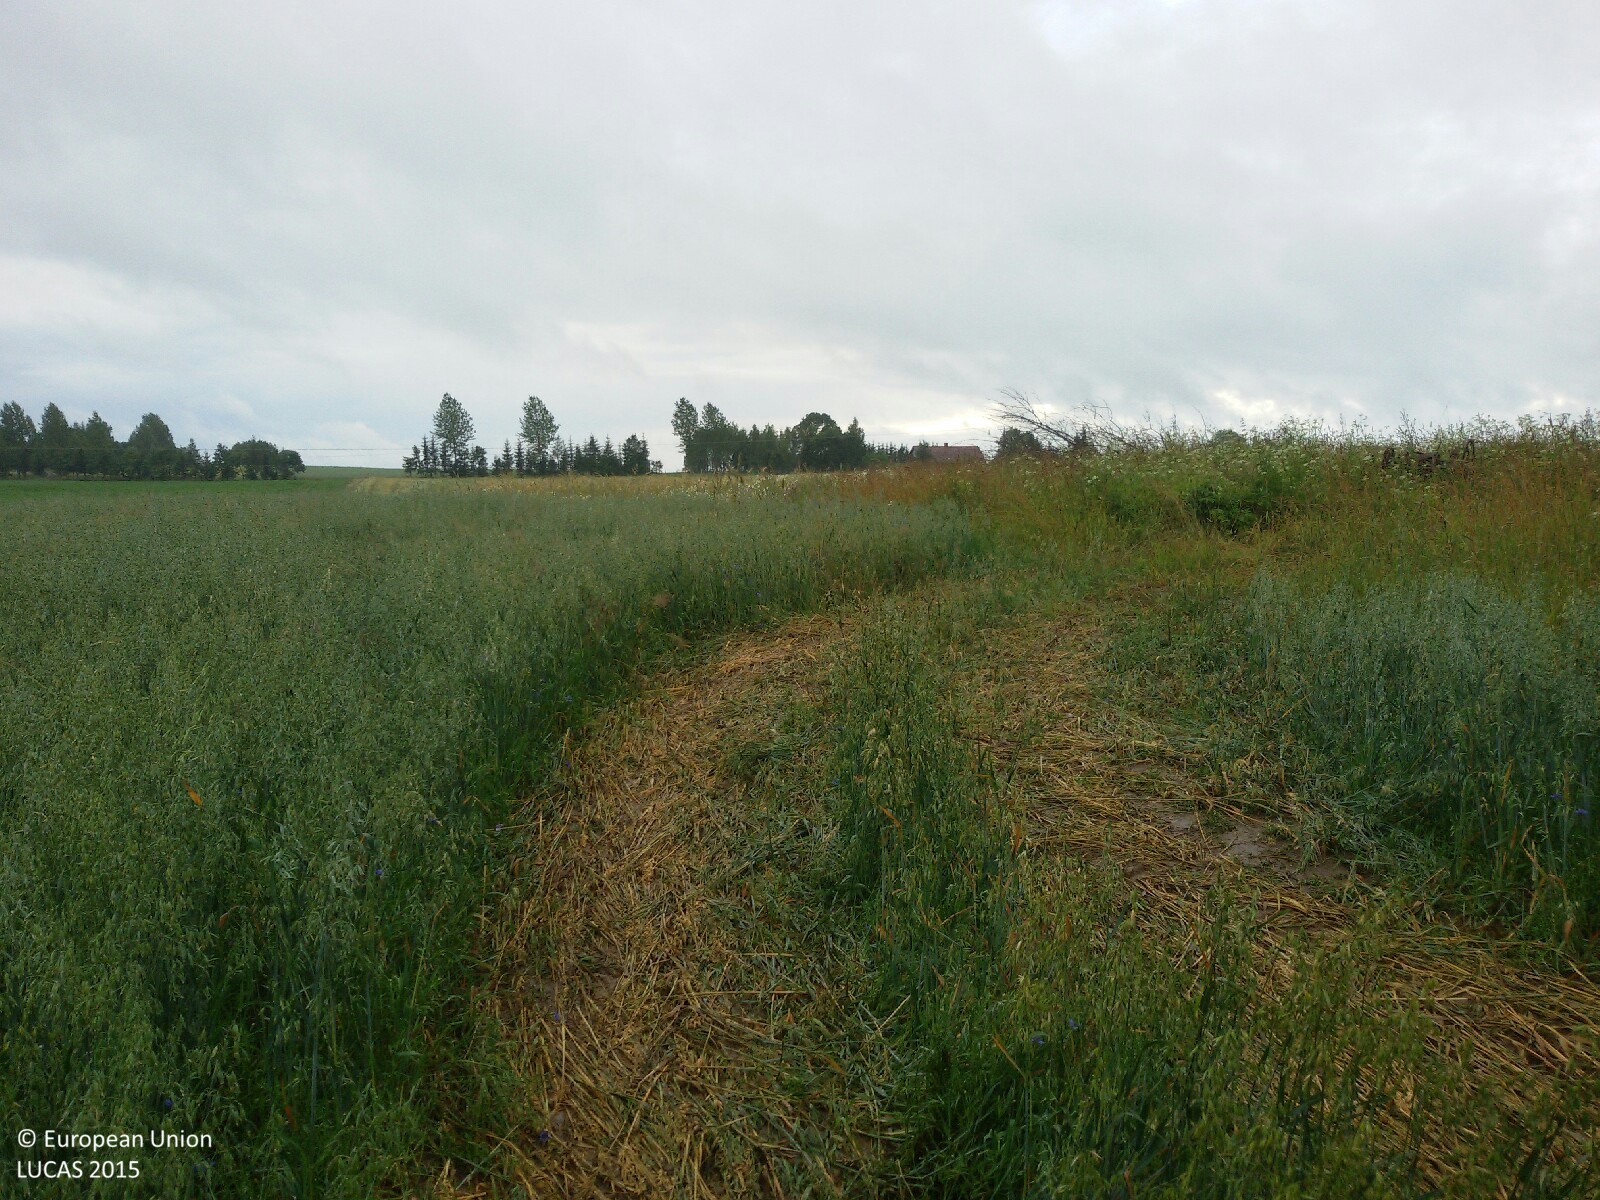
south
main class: Cropland
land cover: Oats
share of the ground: > 75 %
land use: Agriculture (excluding fallow land and kitchen gardens)
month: July
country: PL
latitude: 53.9265
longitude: 20.2524
